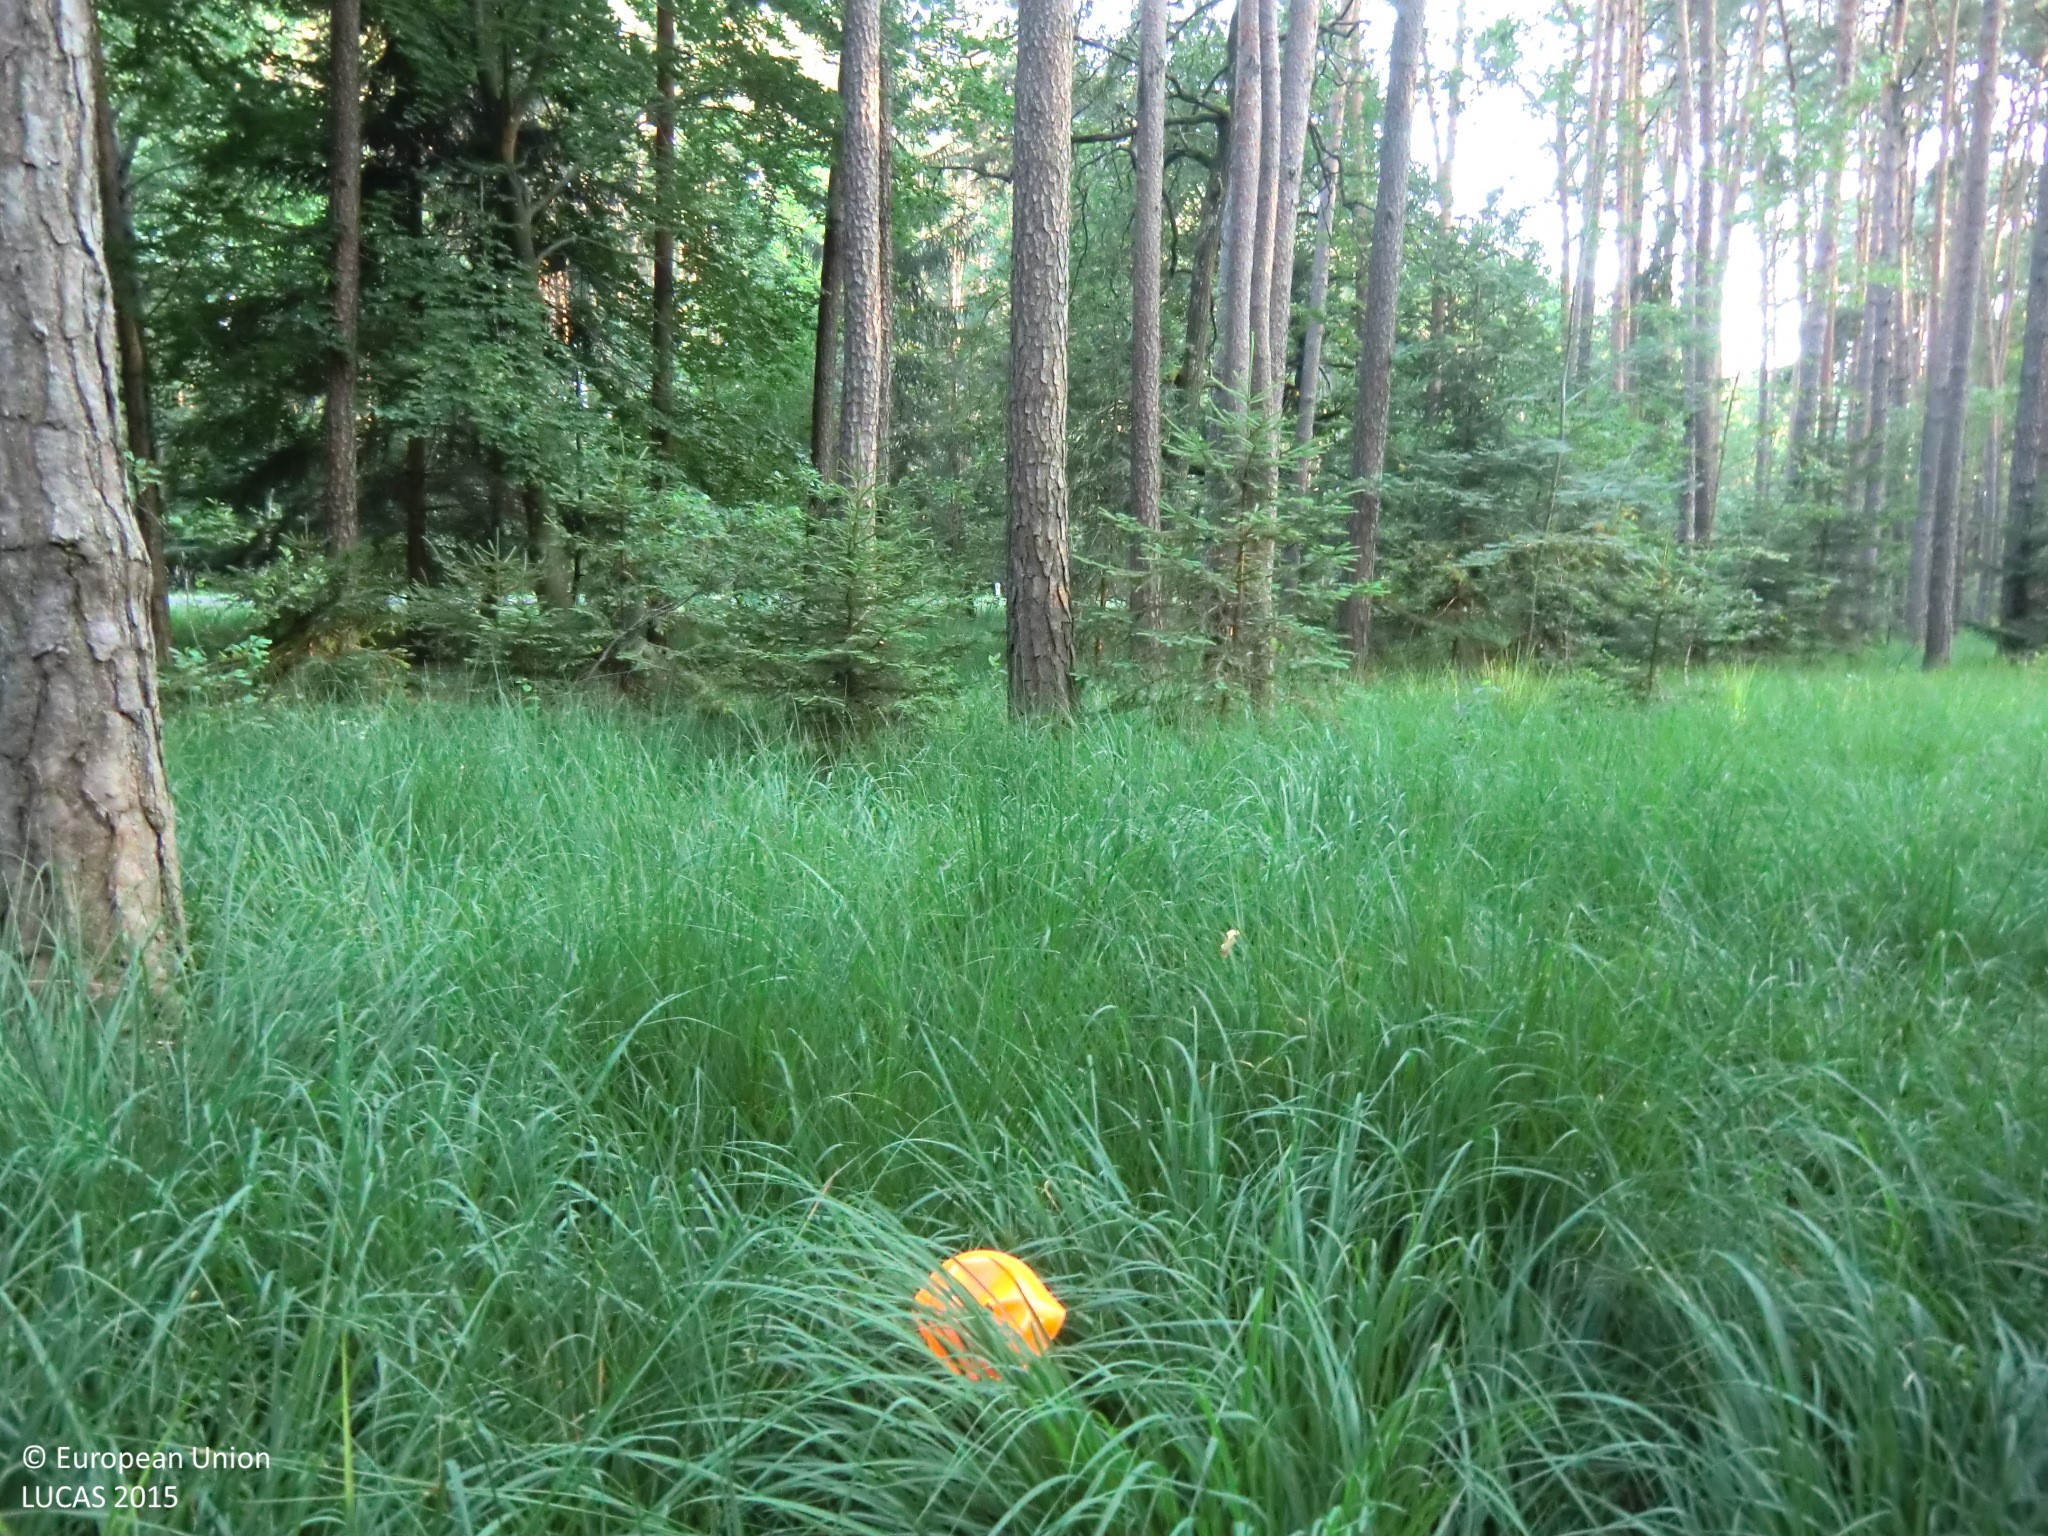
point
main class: Woodland
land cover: Pine dominated coniferous woodland
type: hemiboreal forest and nemoral coniferous forest and mixed broadleaved-coniferous forest
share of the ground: > 75 %
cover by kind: coniferous forest trees 70 %, herbaceous plants 25 %, broadleaved forest trees 5 %
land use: Forestry
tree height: > 5 m
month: July
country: AT
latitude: 47.1605
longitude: 15.9502
